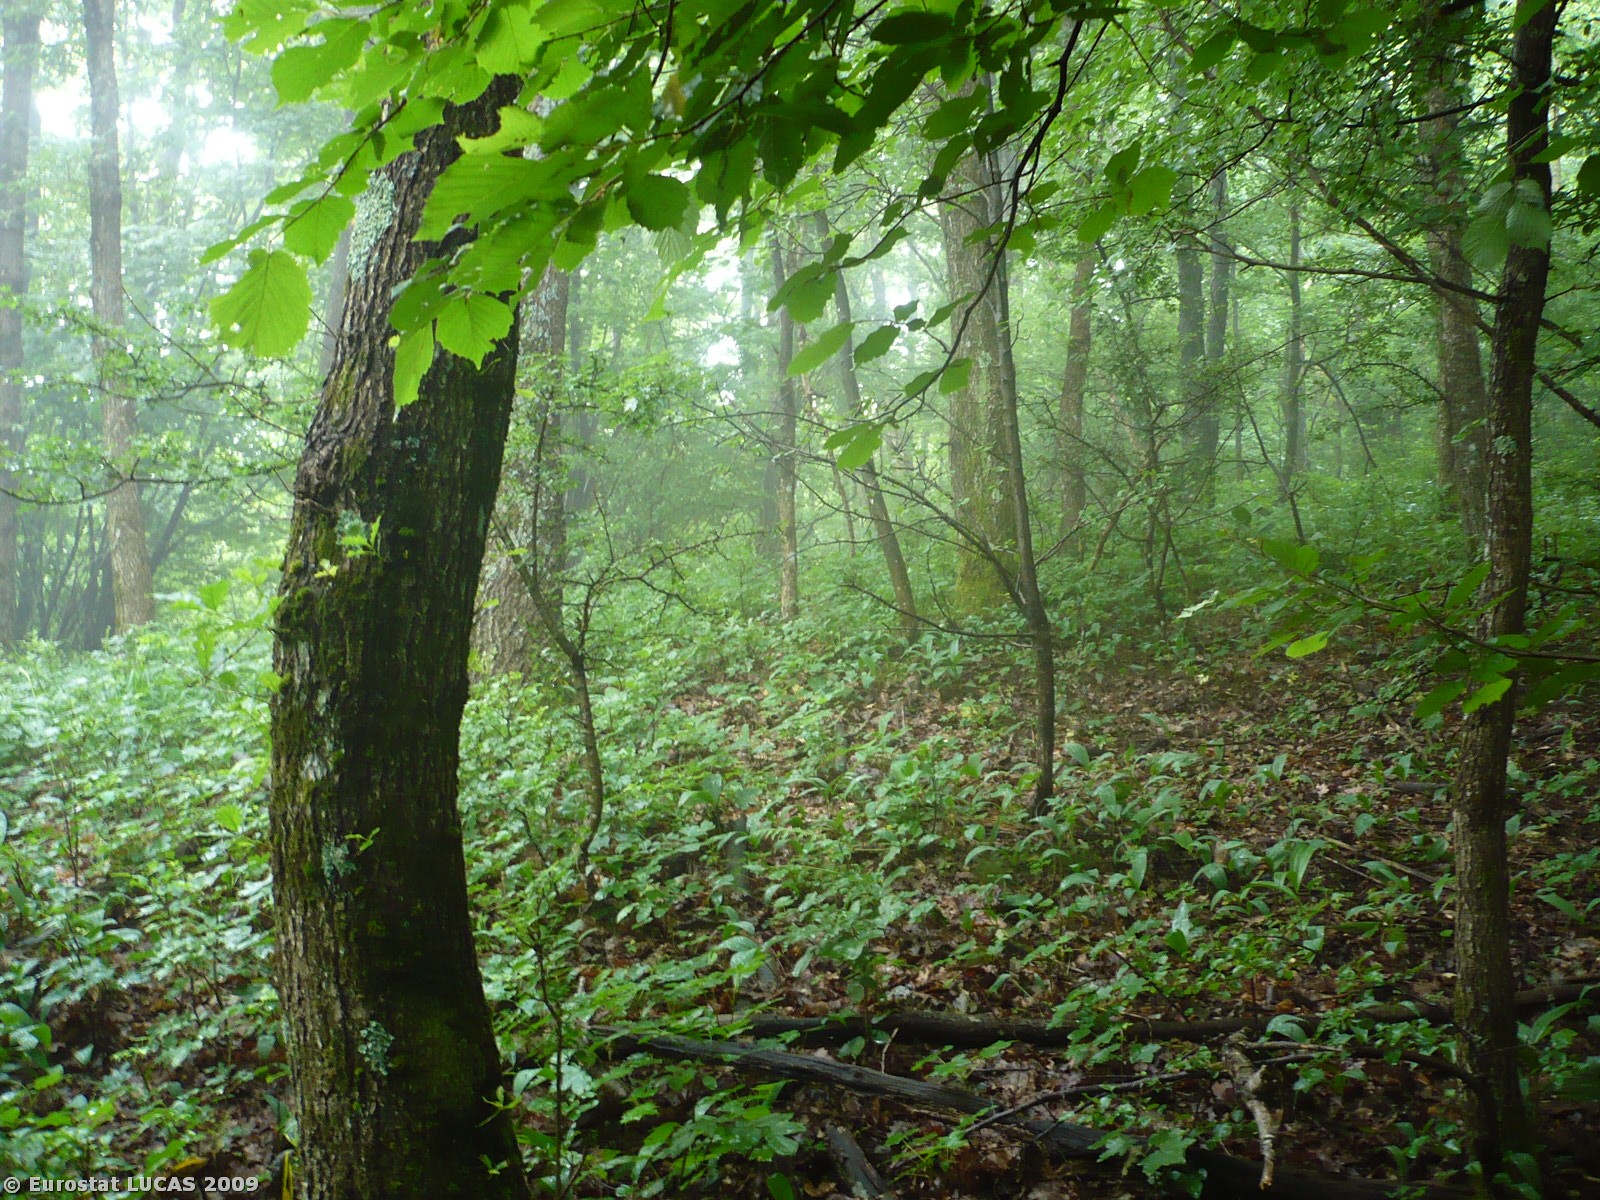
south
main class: Woodland
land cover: Broadleaved woodland
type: acidophilous oak and oak-birch forest
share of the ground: > 75 %
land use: Forestry
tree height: > 5 m
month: June
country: SI
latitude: 45.5247
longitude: 14.3101
